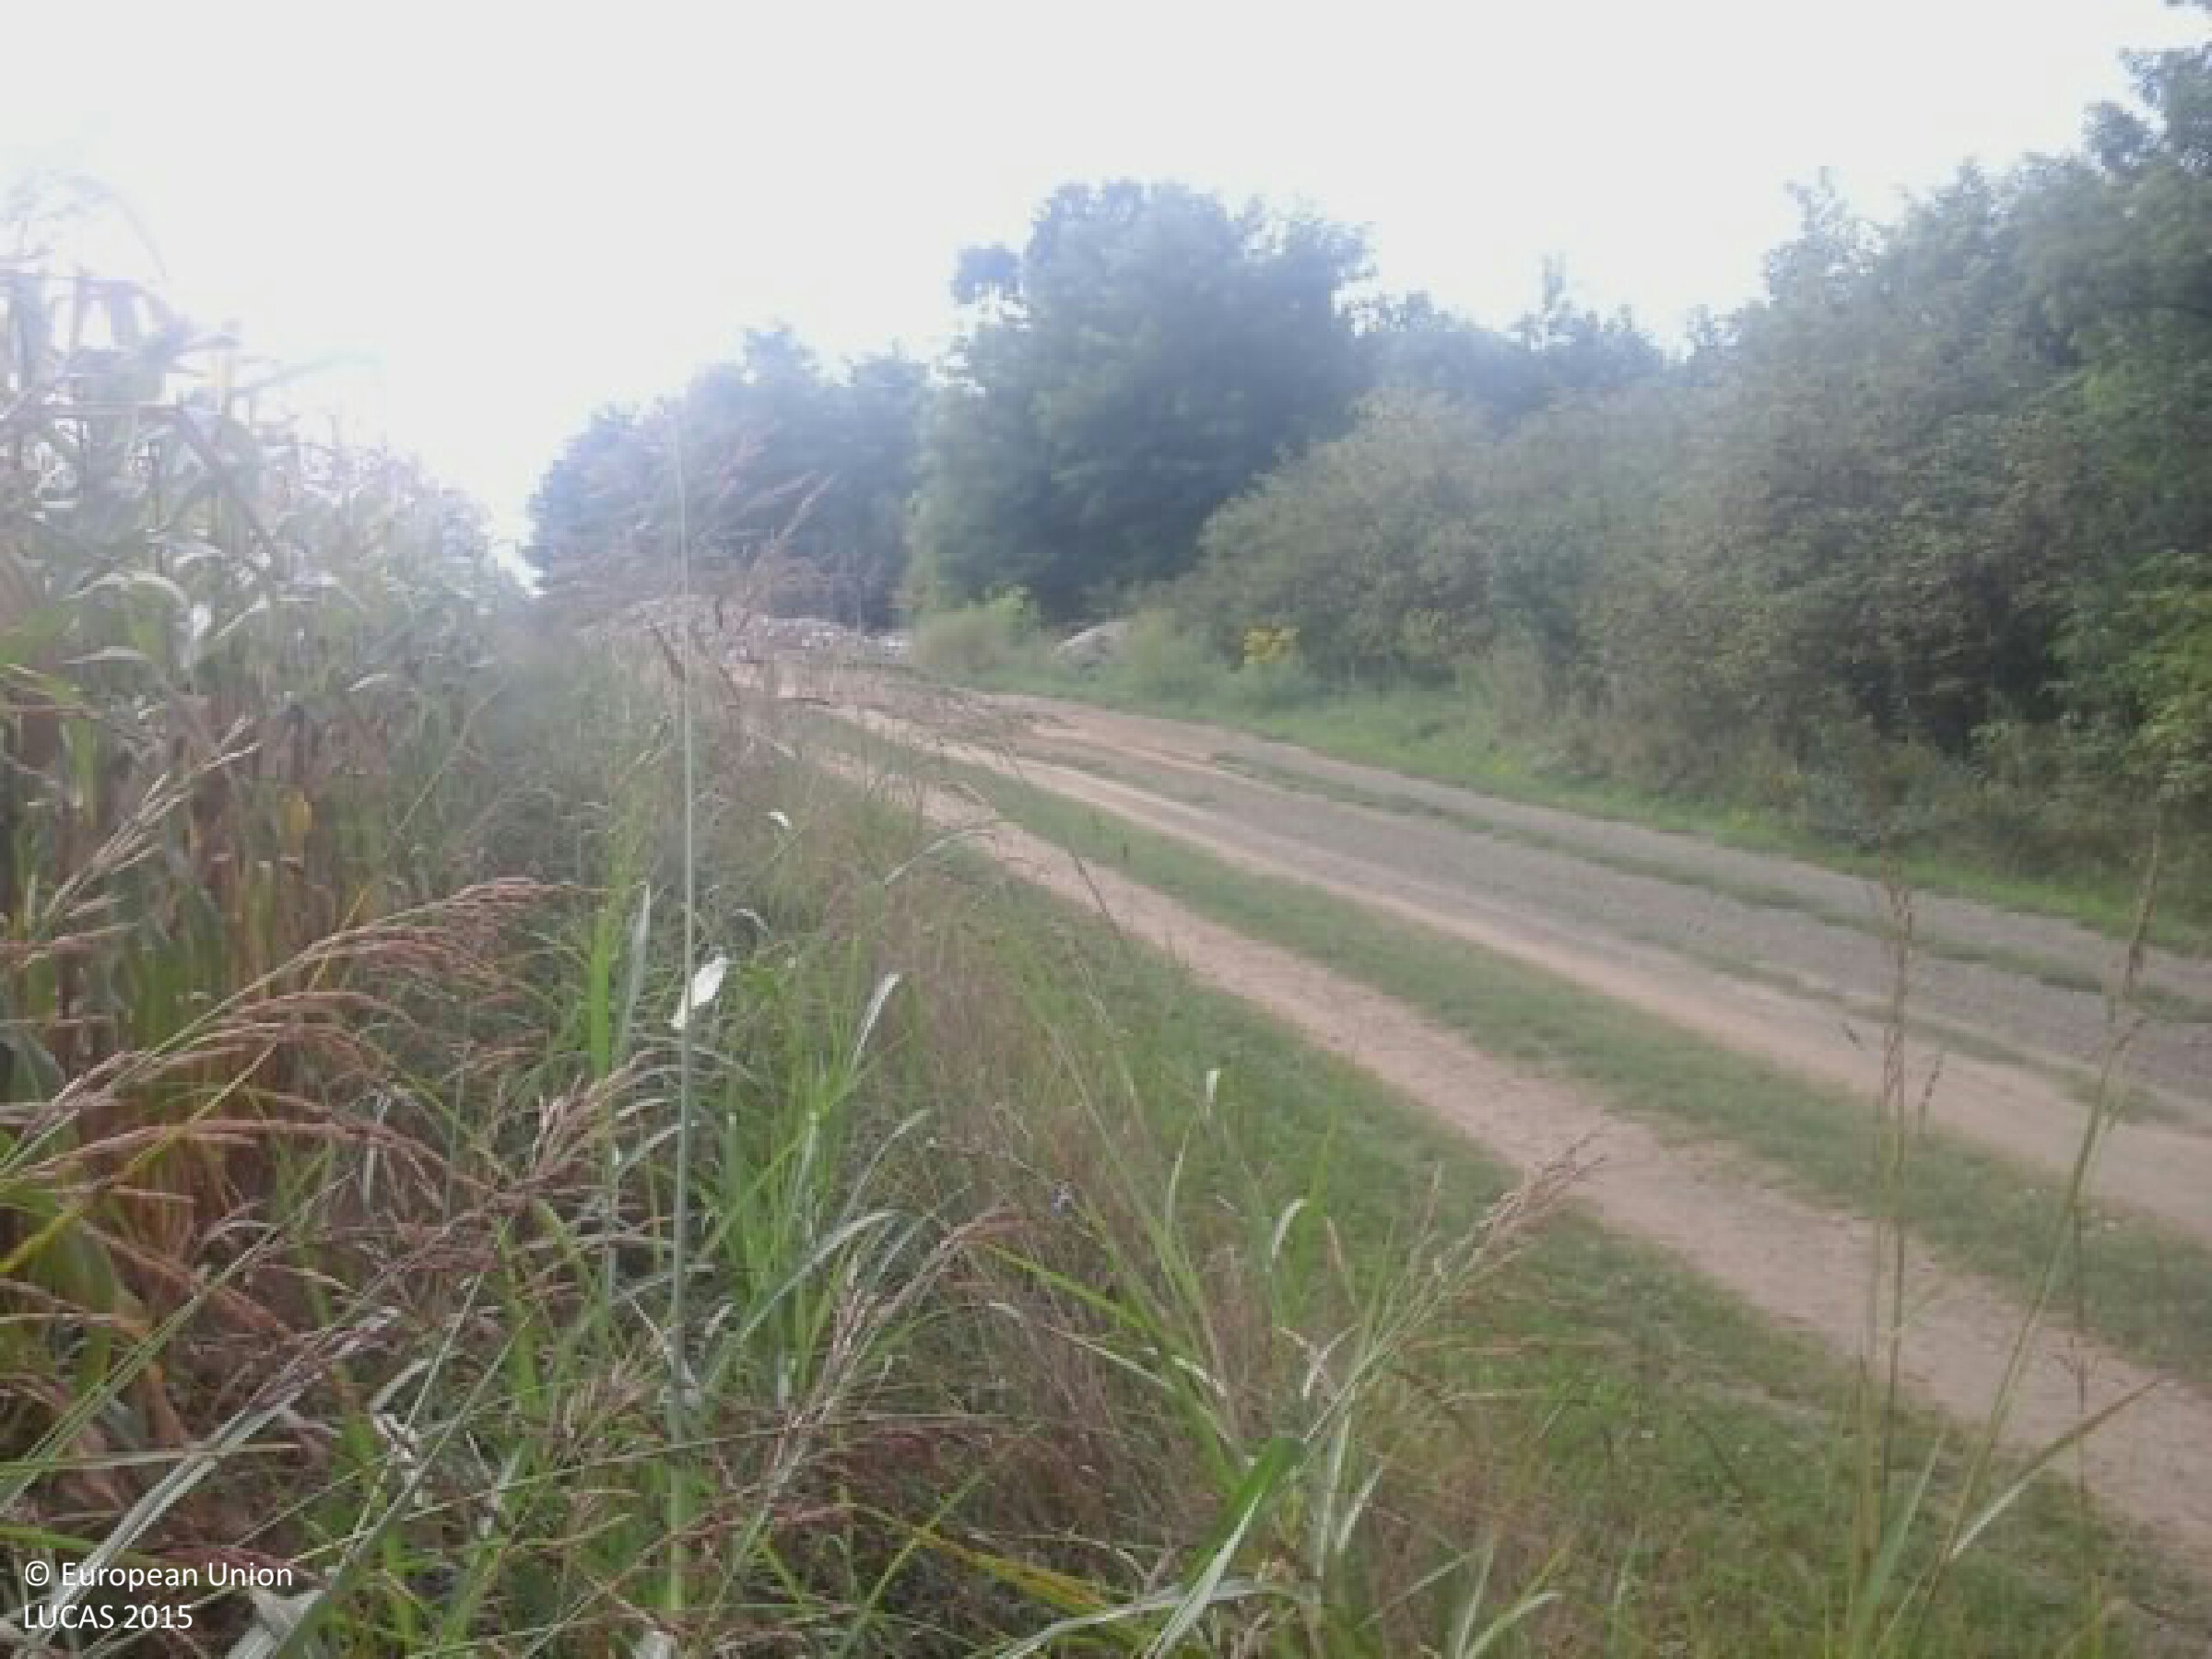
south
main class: Cropland
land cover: Maize
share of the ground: > 75 %
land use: Agriculture (excluding fallow land and kitchen gardens)
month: August
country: HU
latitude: 46.4354
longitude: 17.6974
